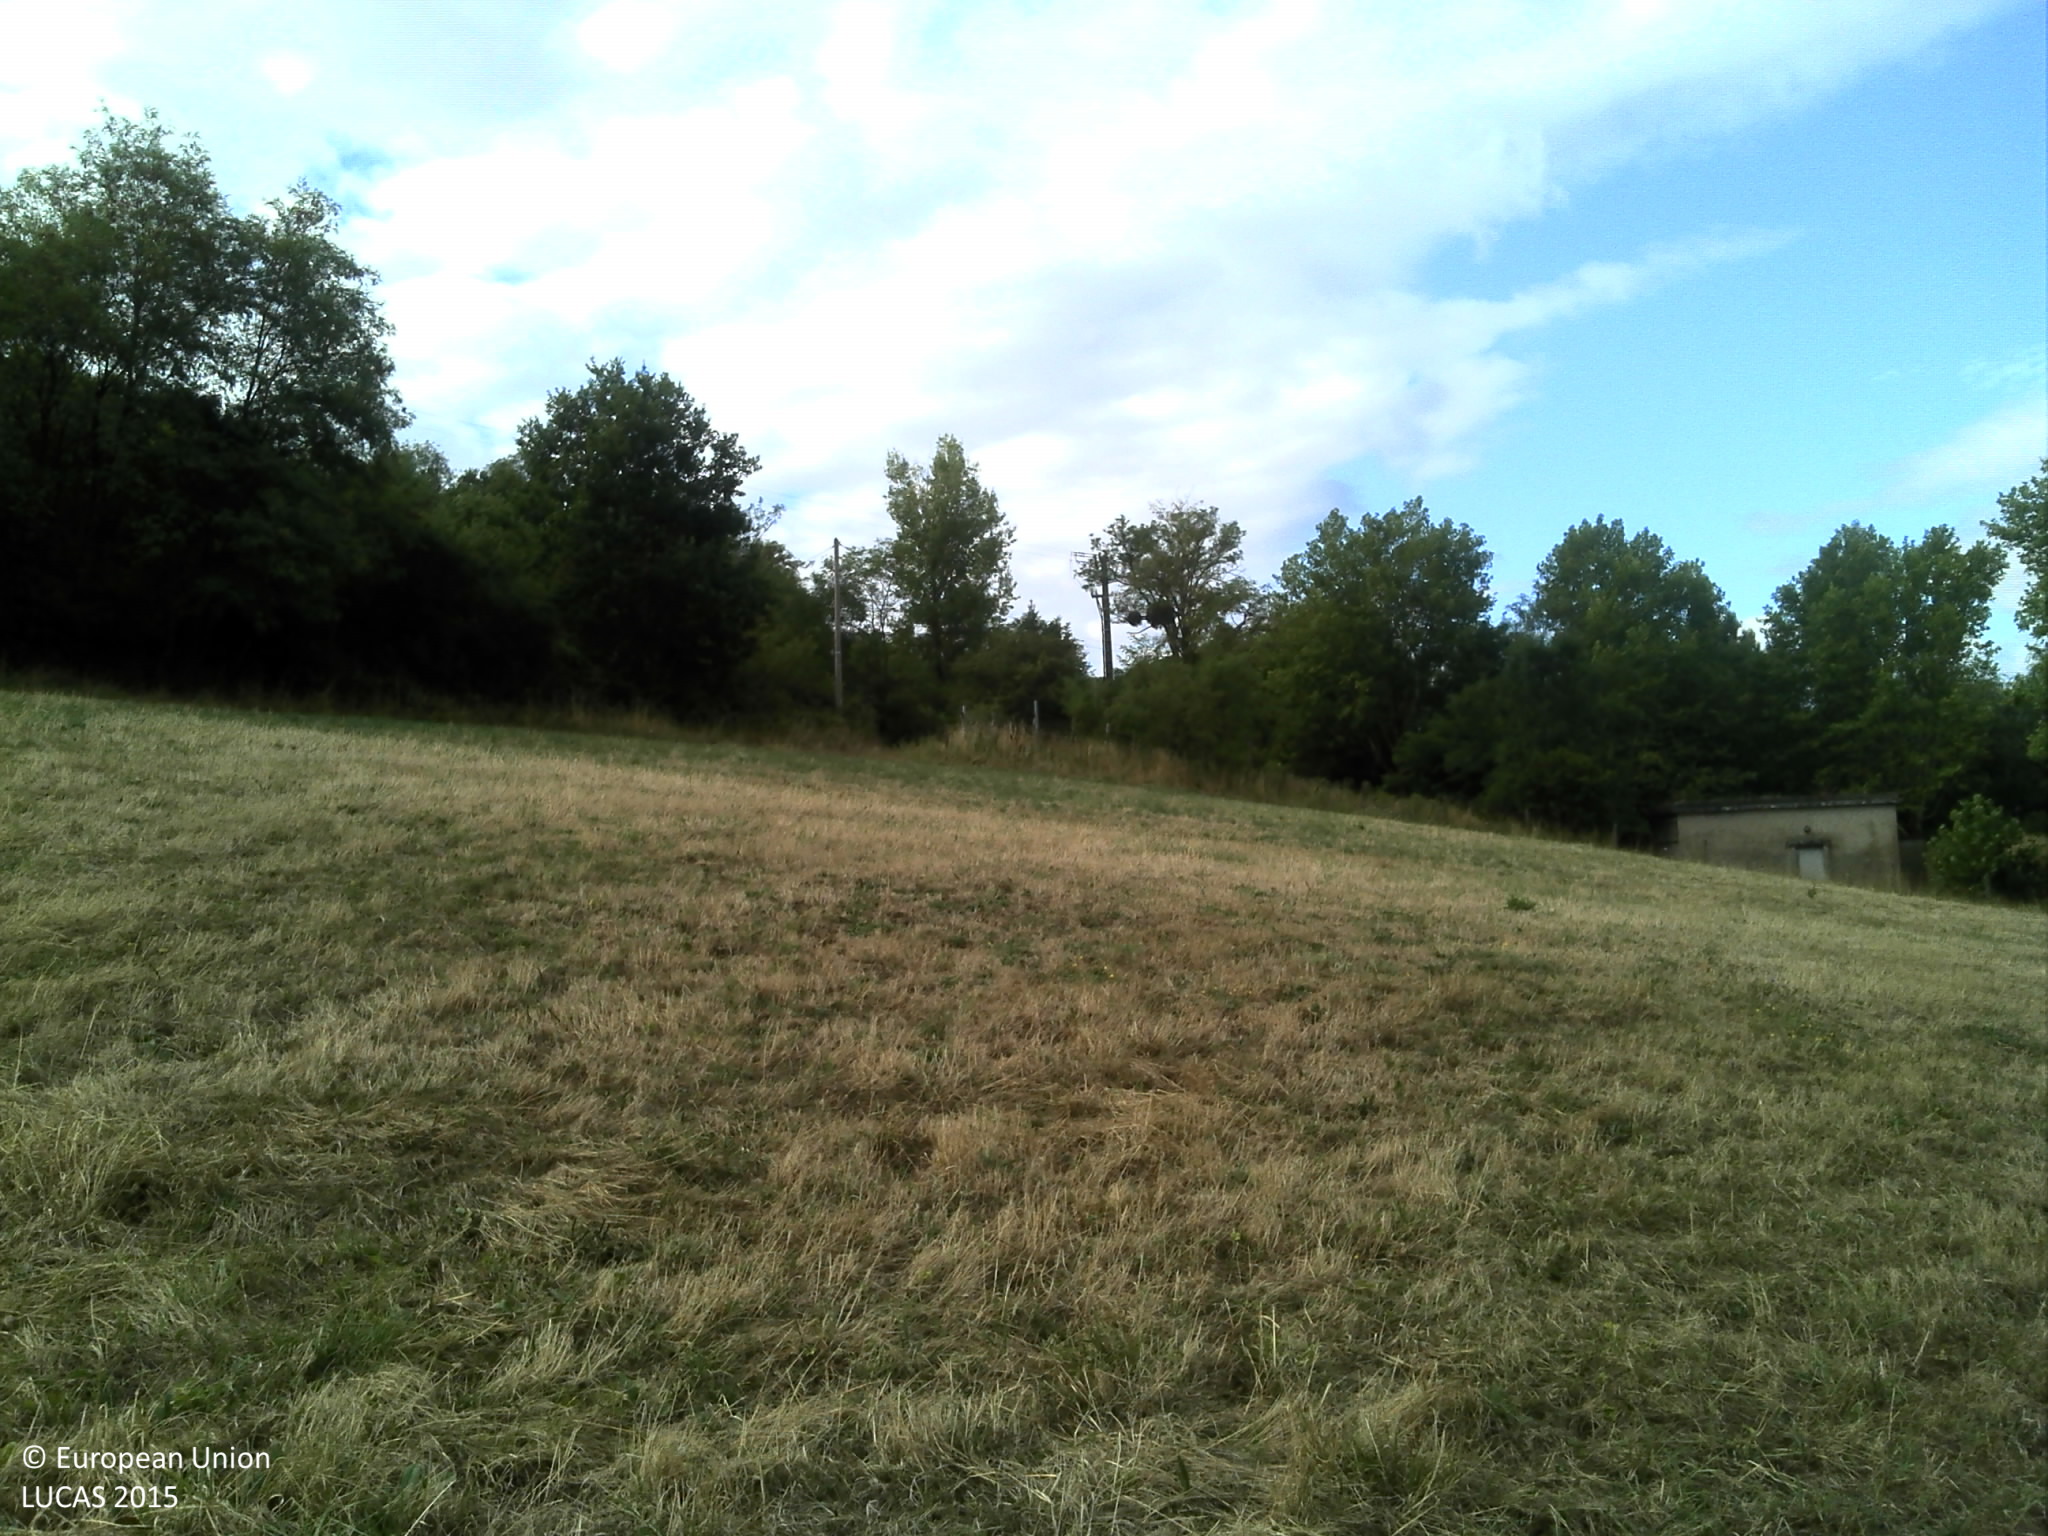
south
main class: Grassland
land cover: Grassland without tree/shrub cover
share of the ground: > 75 %
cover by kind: herbaceous plants 100 %
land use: Agriculture (excluding fallow land and kitchen gardens)
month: July
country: FR
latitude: 45.8821
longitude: 4.1136
